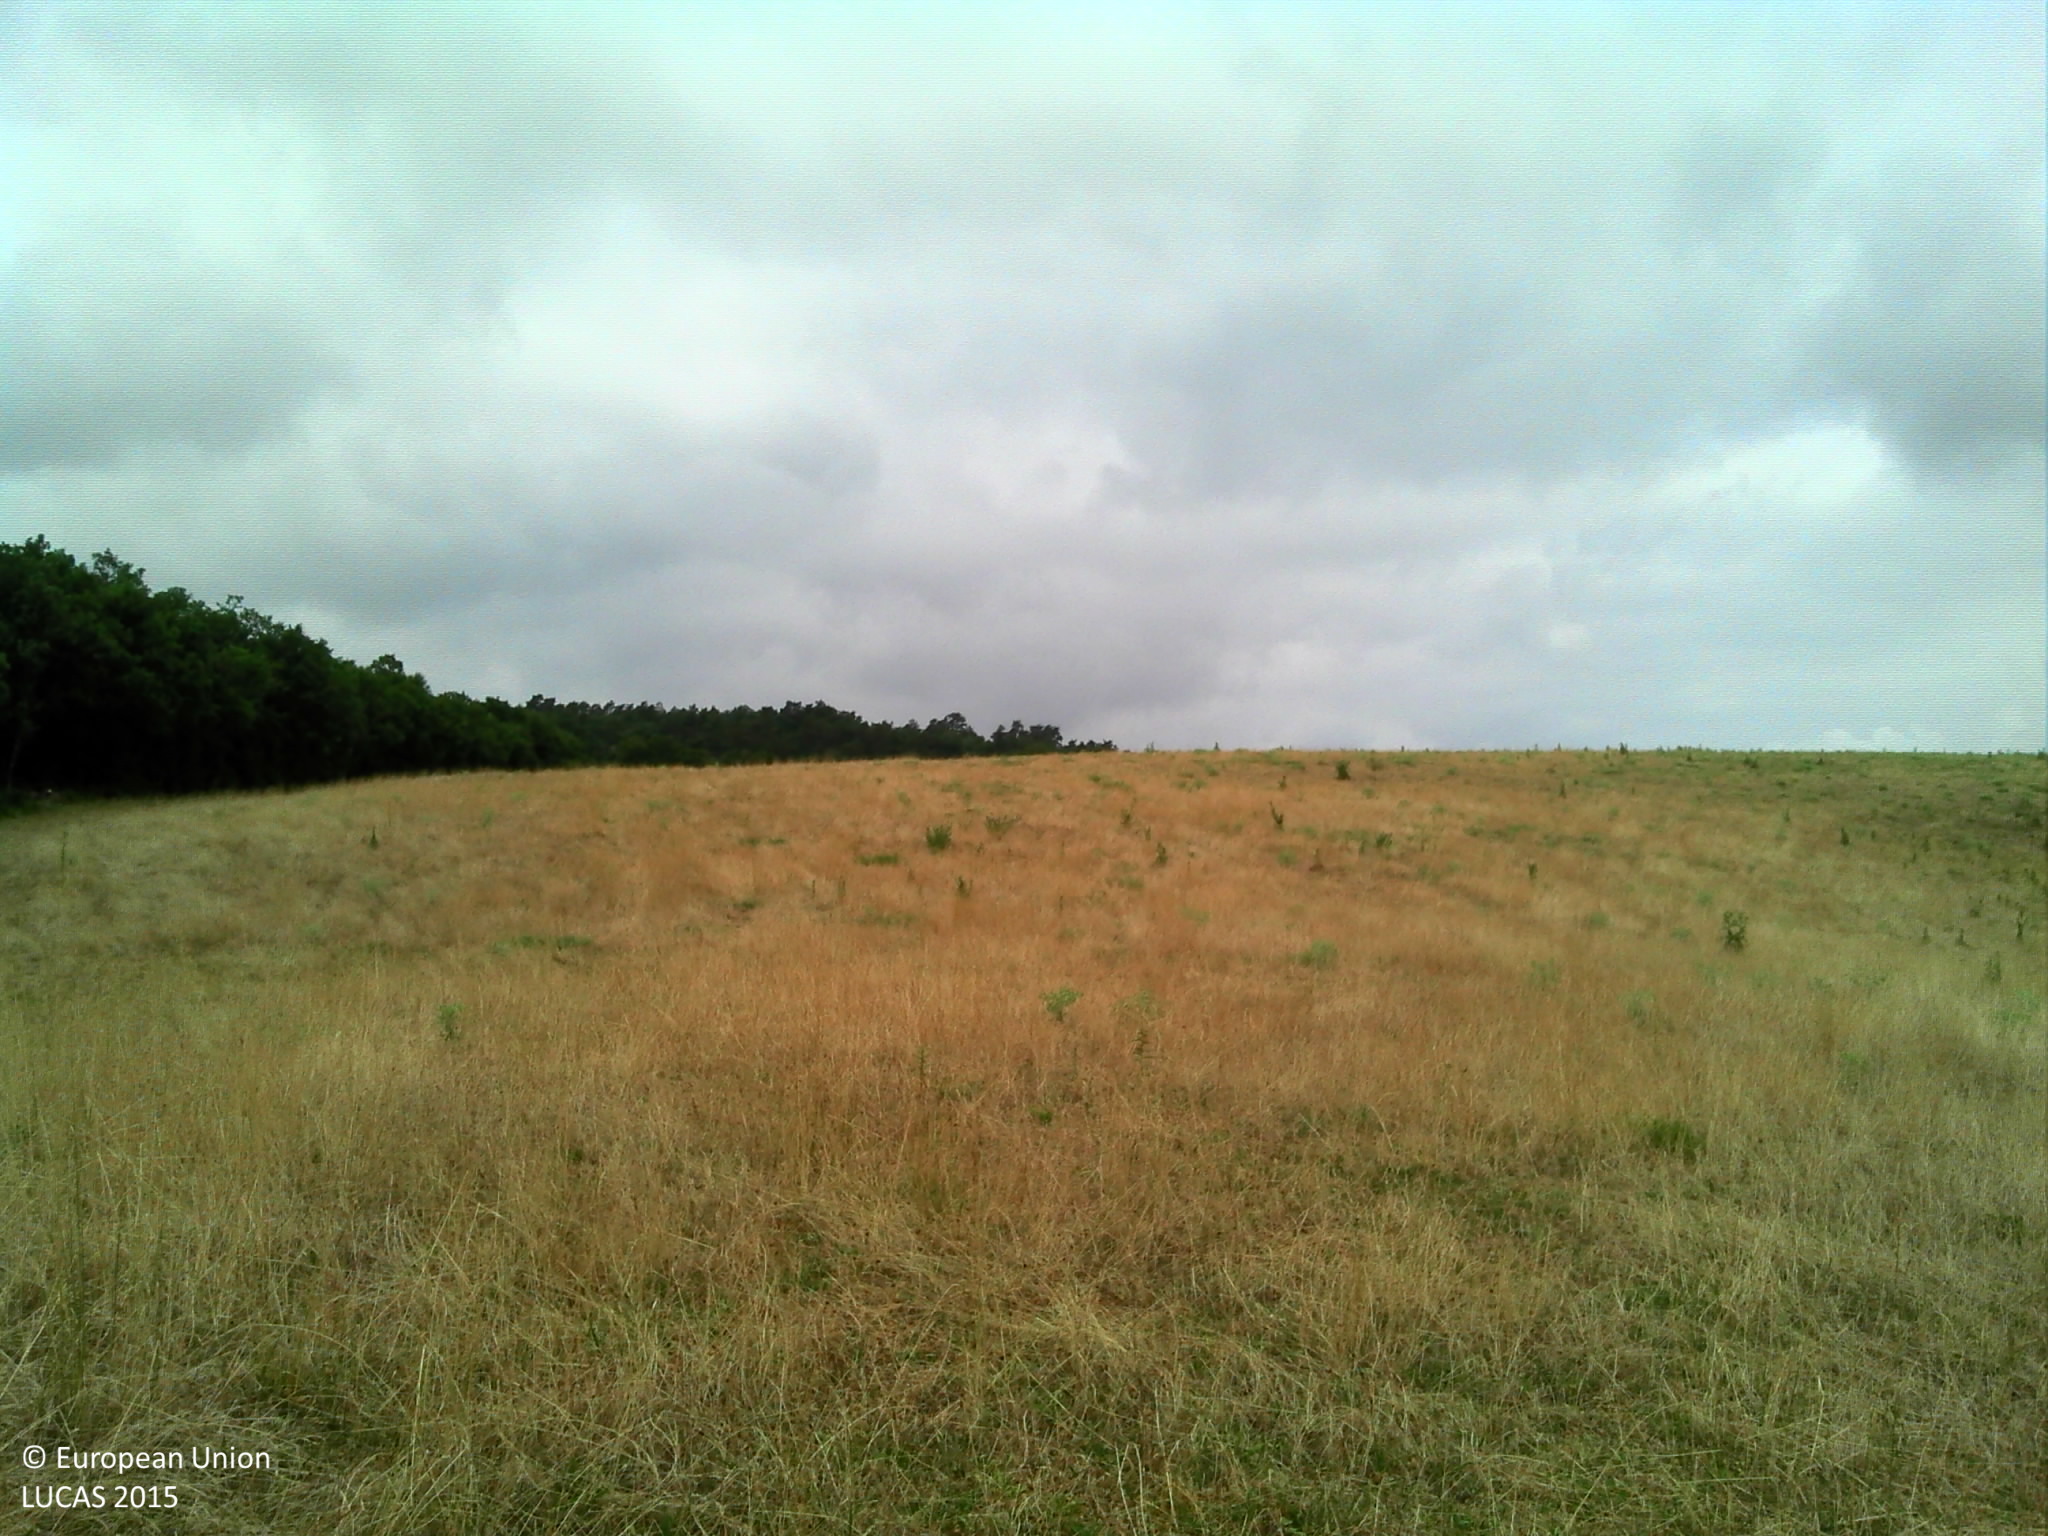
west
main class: Grassland
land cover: Grassland without tree/shrub cover
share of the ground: > 75 %
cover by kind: herbaceous plants 95 %, shrubs 5 %
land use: Agriculture (excluding fallow land and kitchen gardens)
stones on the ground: 25 - 50 %
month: July
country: FR
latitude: 44.4076
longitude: 3.0605
